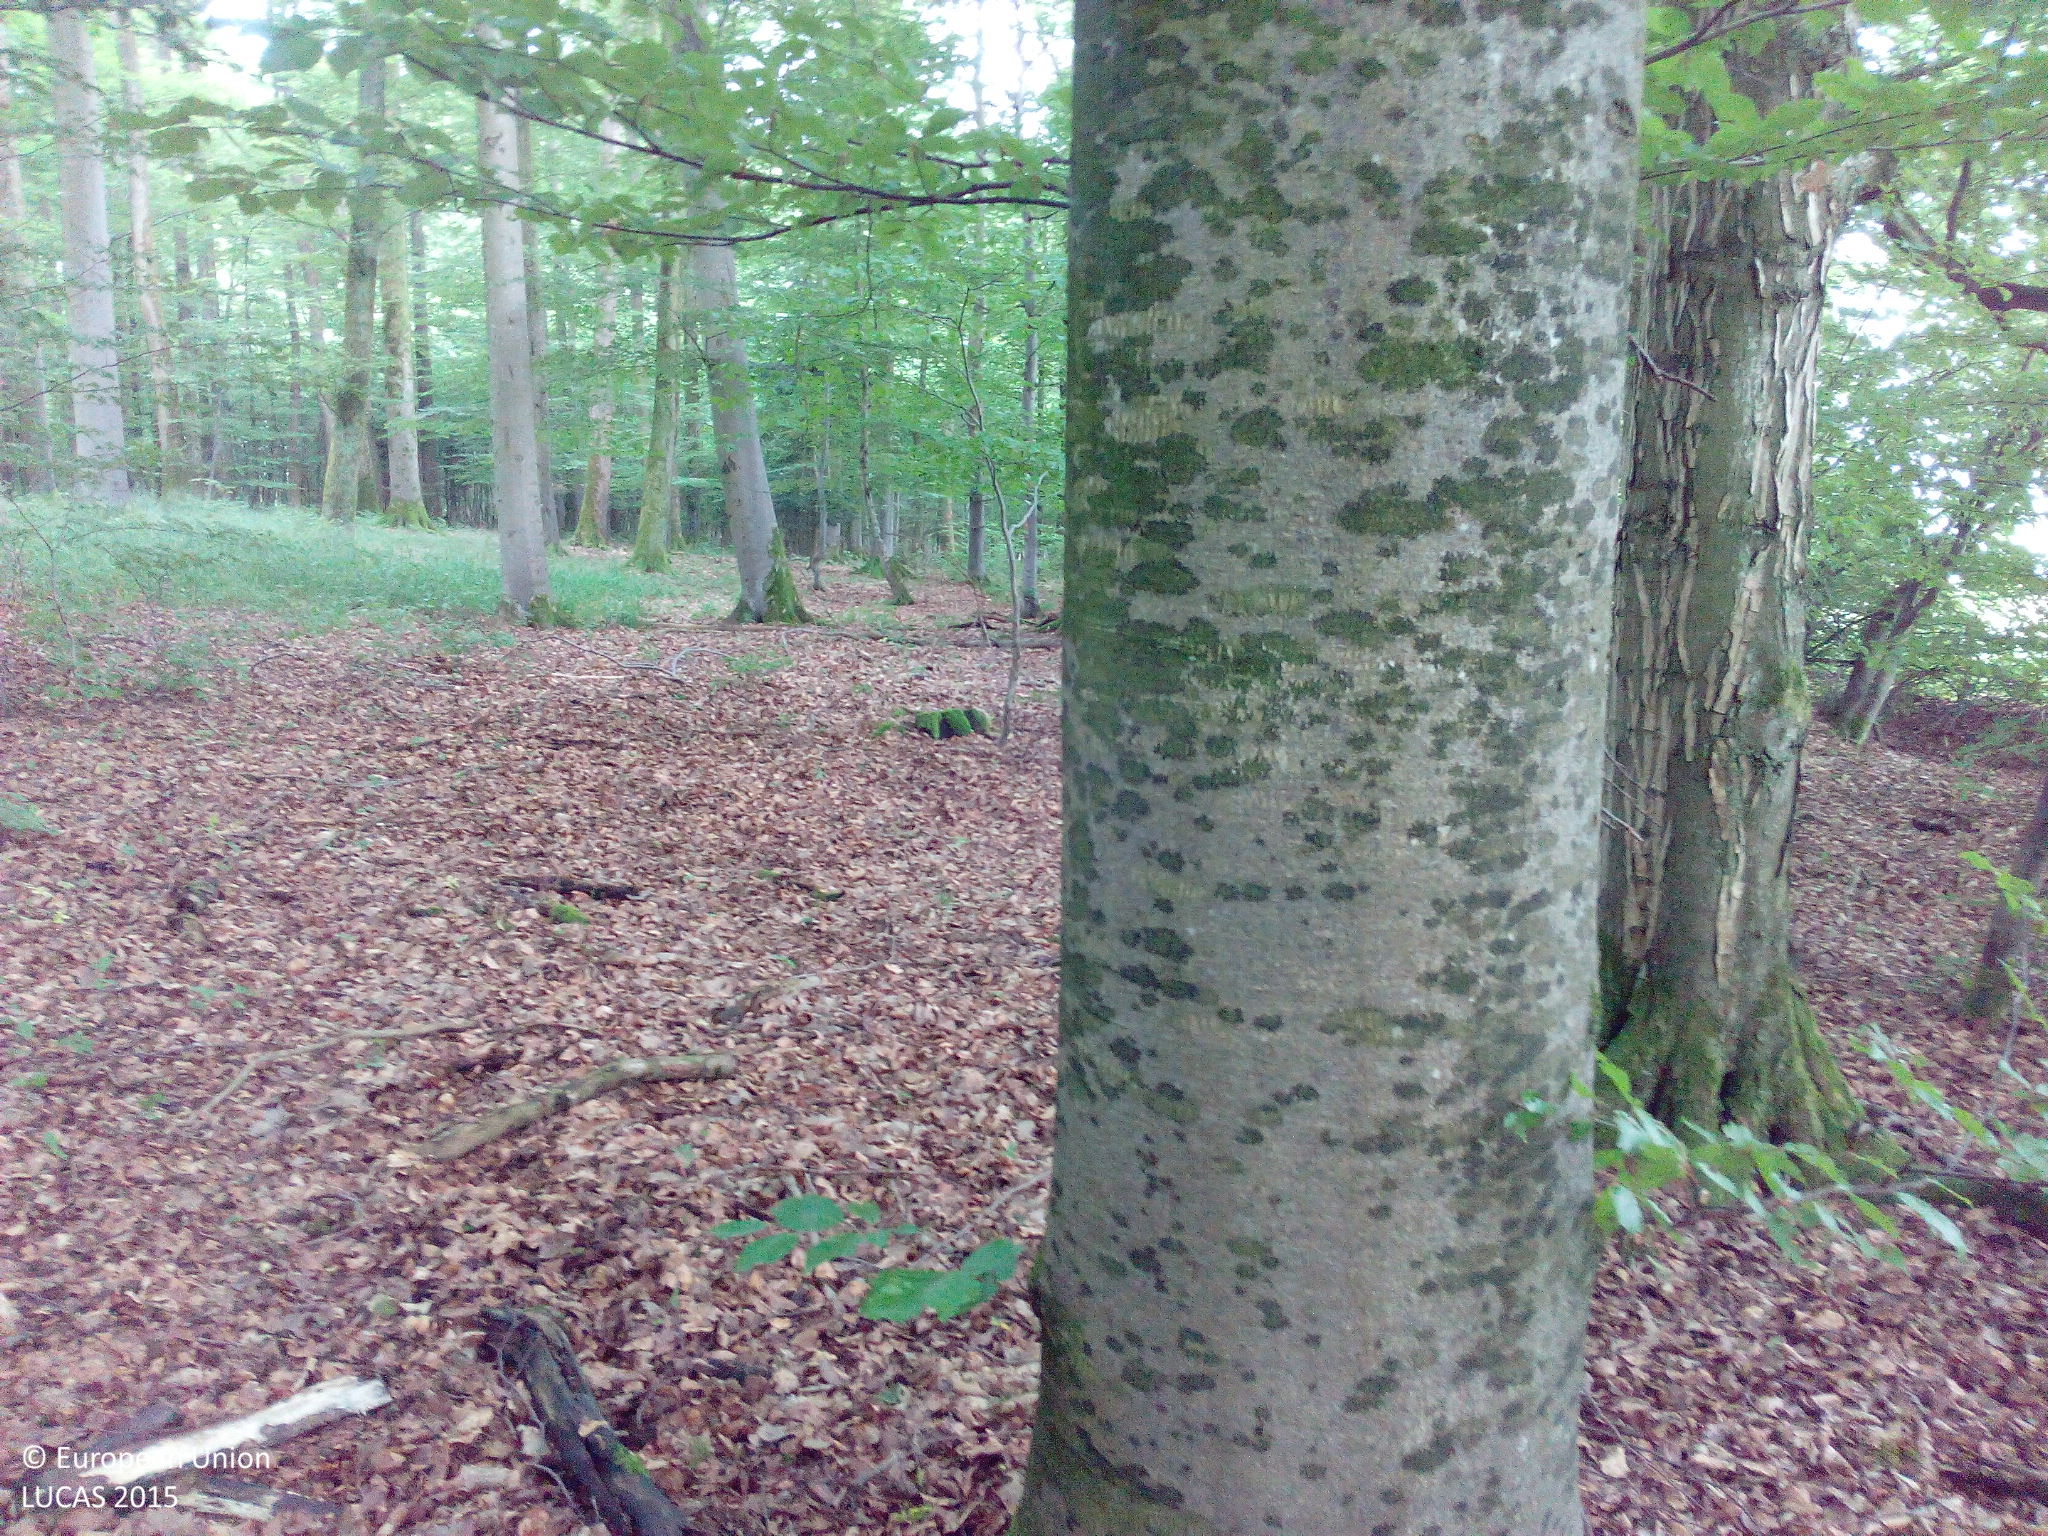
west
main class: Woodland
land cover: Broadleaved woodland
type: mesophytic deciduous forest
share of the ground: > 75 %
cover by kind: broadleaved forest trees 100 %
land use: Forestry
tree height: > 5 m
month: June
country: DE
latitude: 48.7269
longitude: 9.6875
